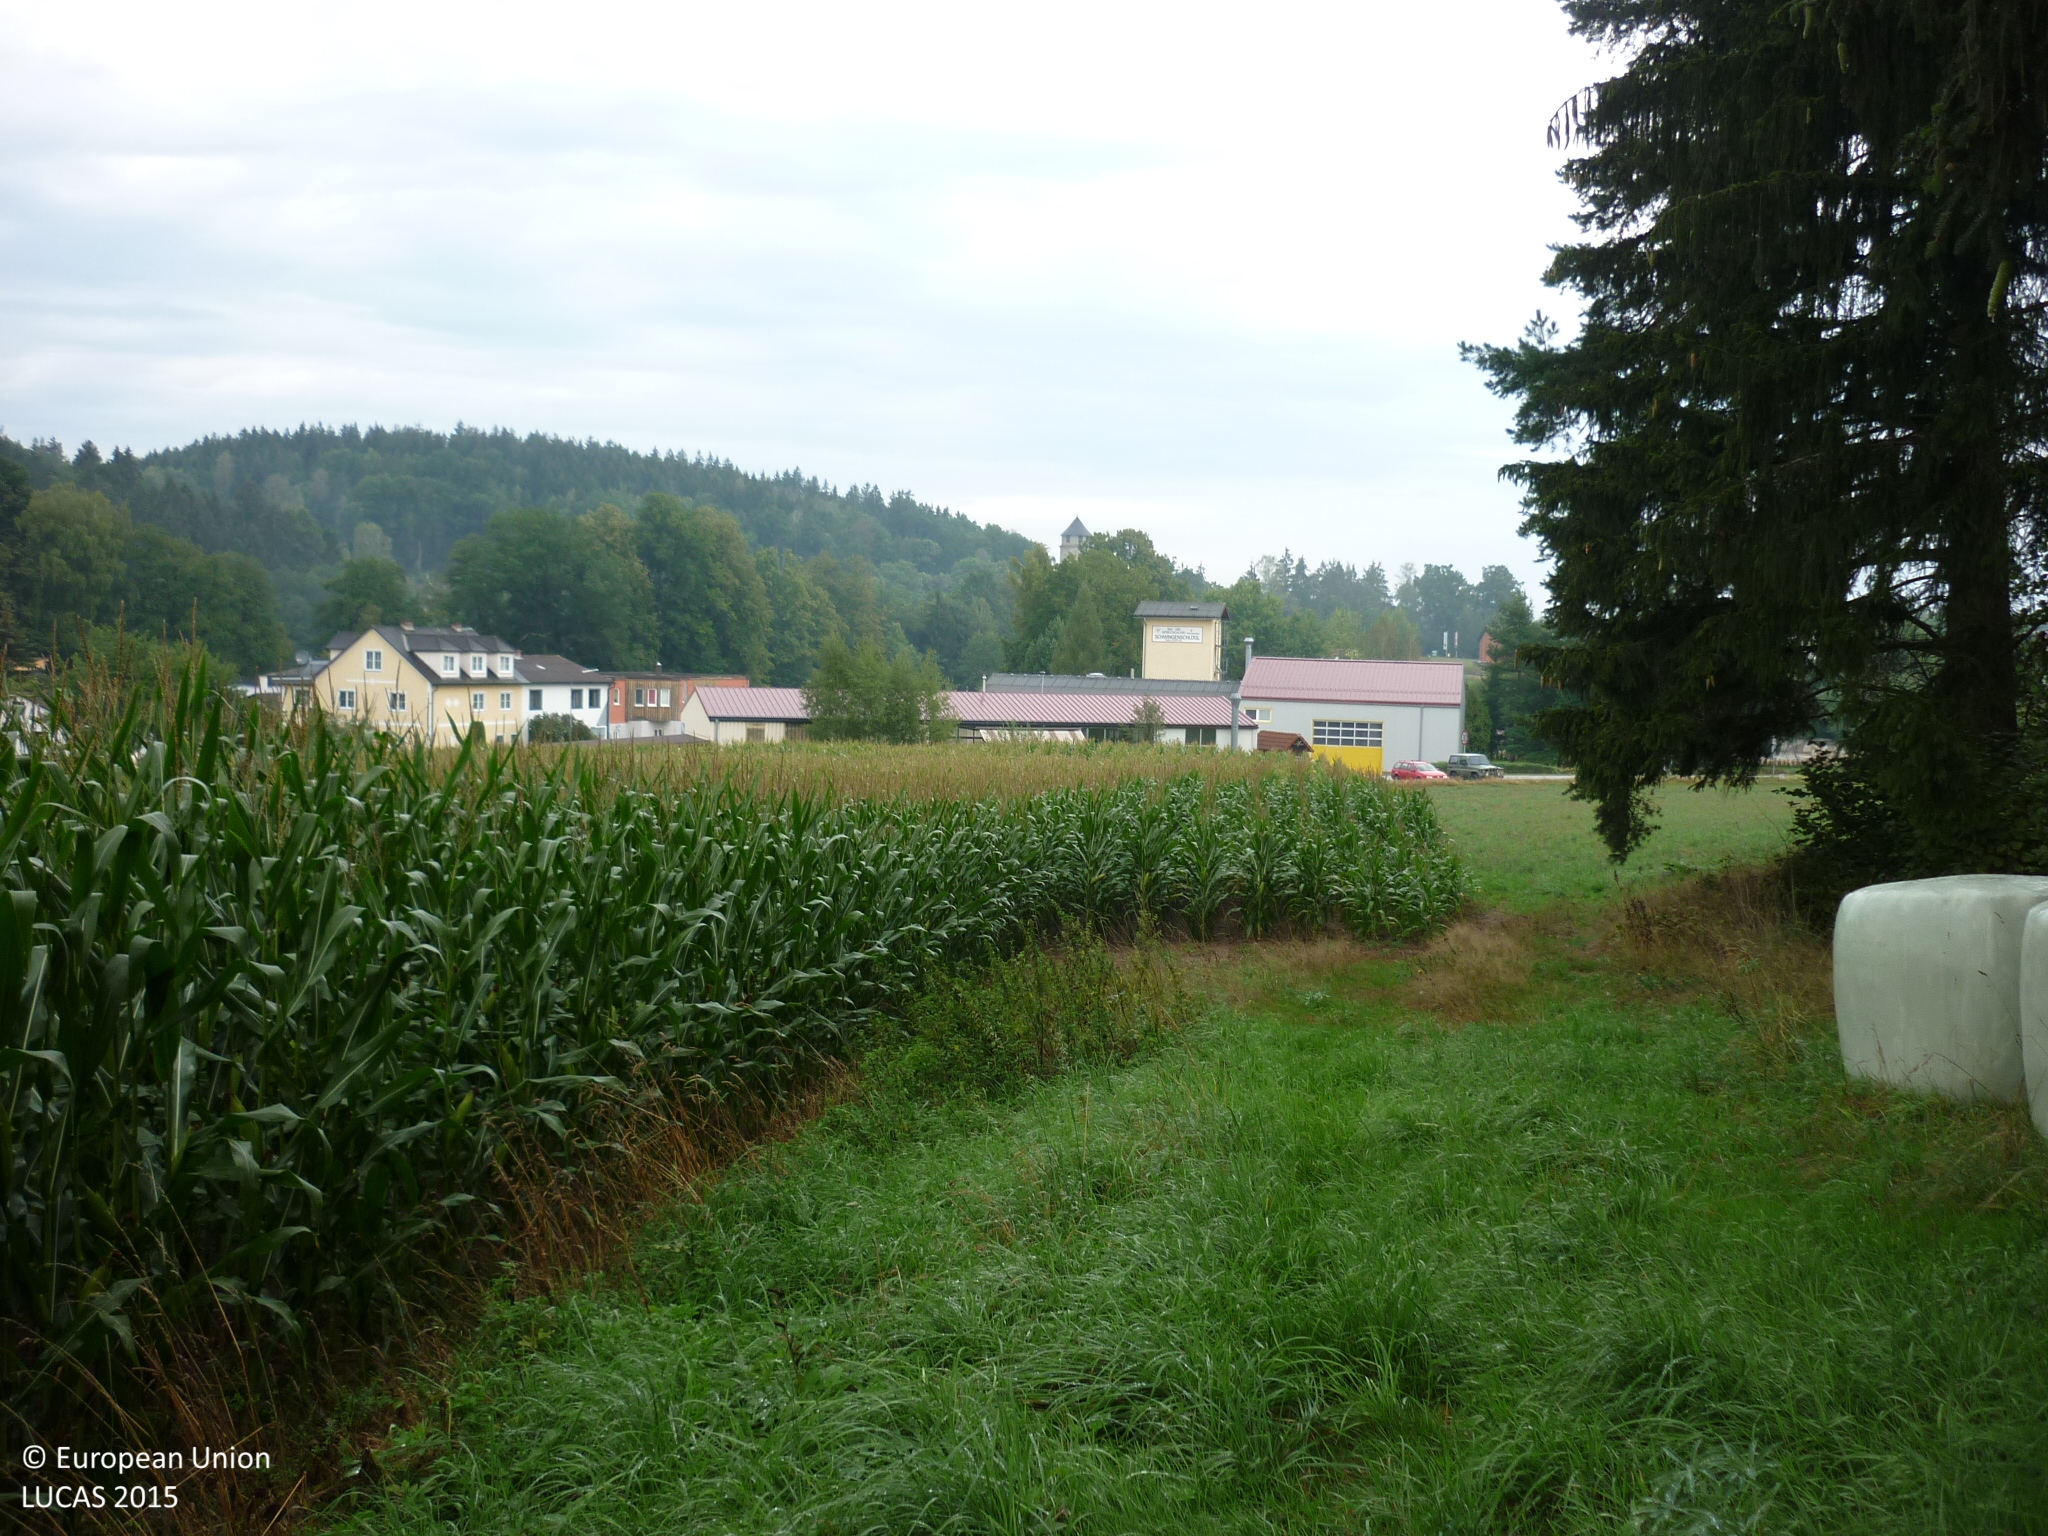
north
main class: Cropland
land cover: Maize
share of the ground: > 75 %
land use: Agriculture (excluding fallow land and kitchen gardens)
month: September
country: AT
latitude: 48.9376
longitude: 15.0396
